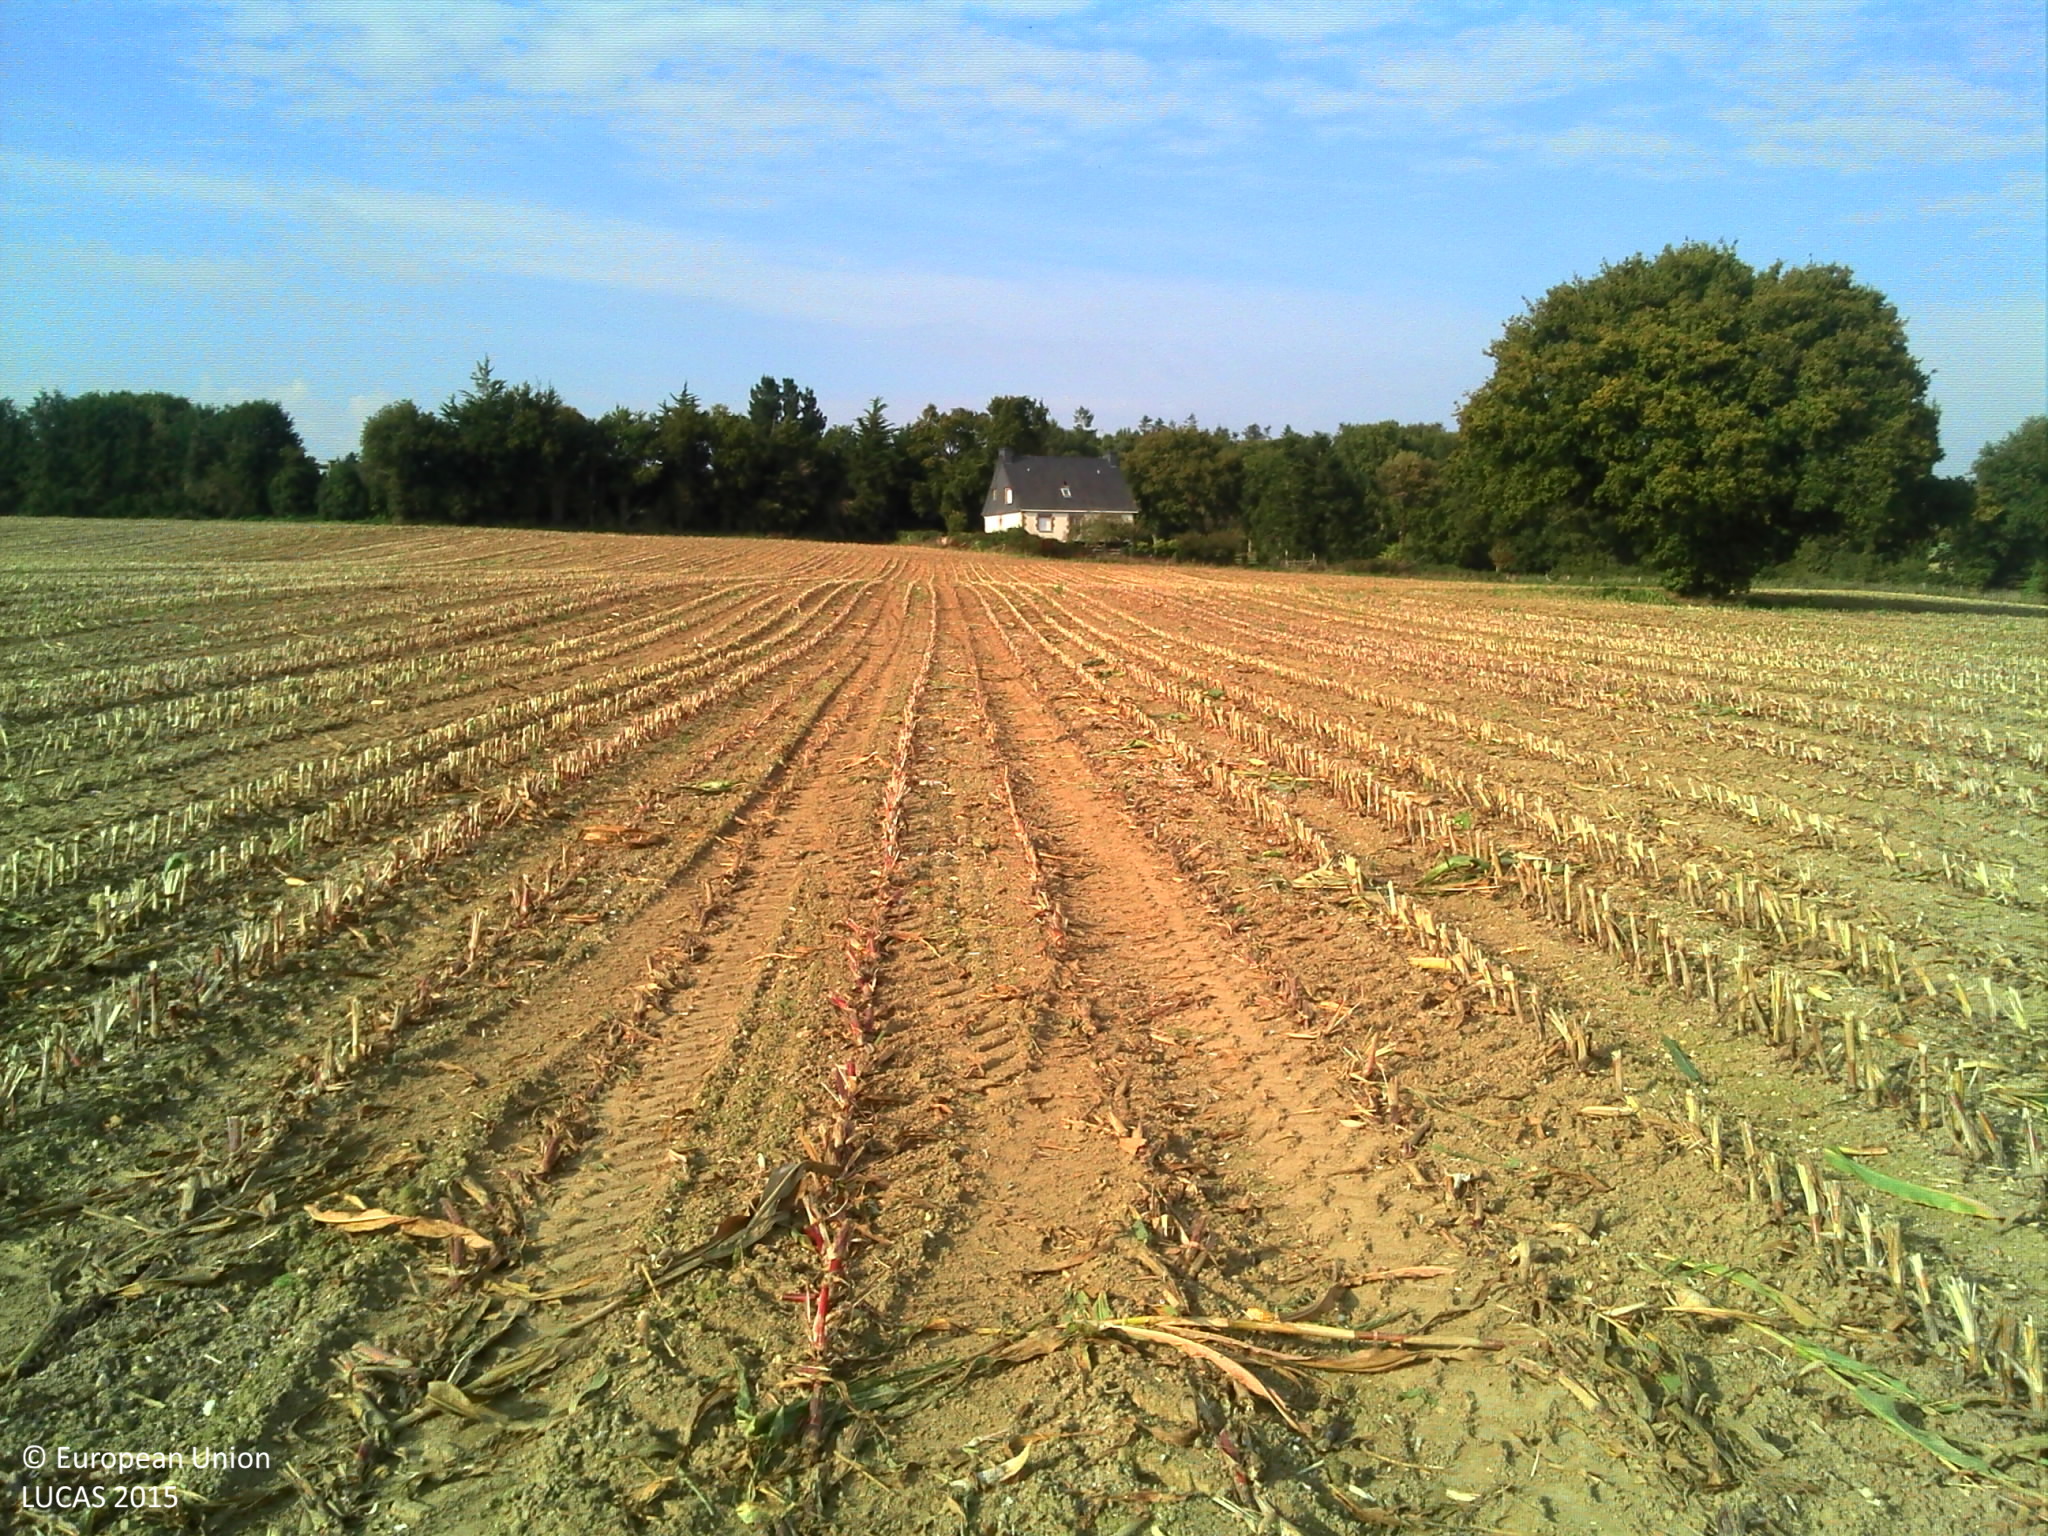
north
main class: Cropland
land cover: Maize
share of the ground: < 10 %
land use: Agriculture (excluding fallow land and kitchen gardens)
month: October
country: FR
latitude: 47.8194
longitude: -2.3304
